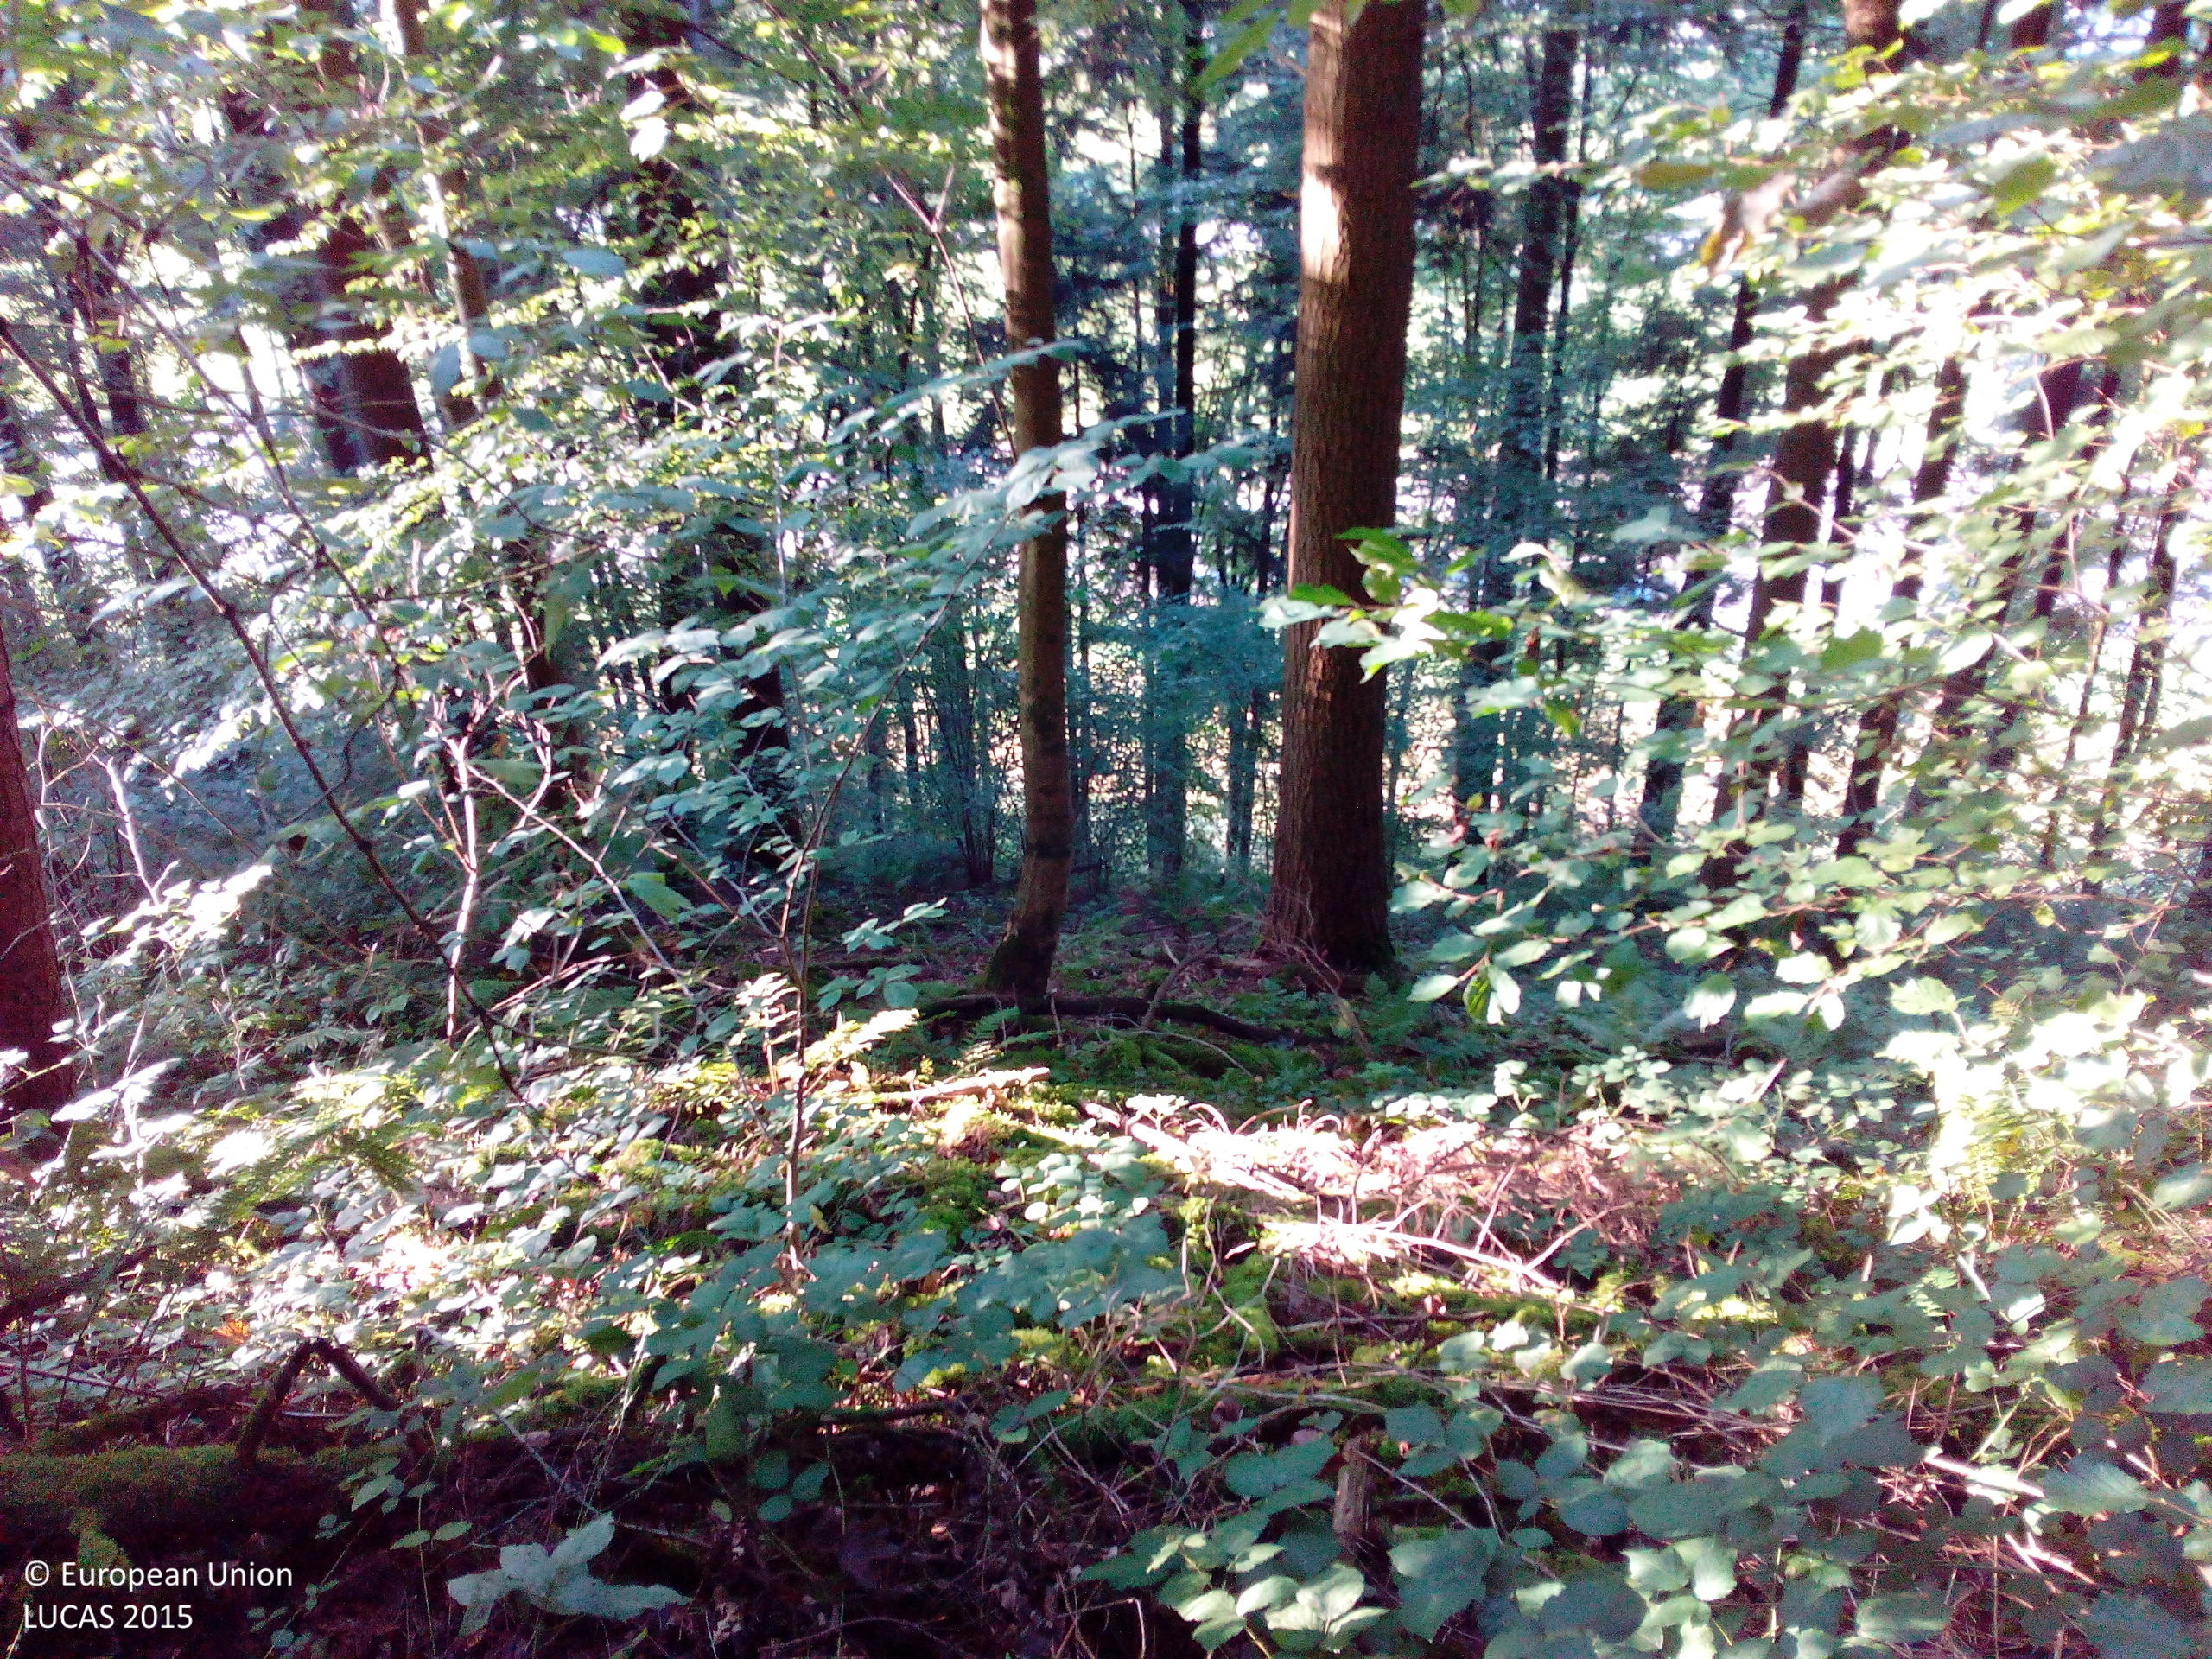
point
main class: Woodland
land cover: Spruce dominated mixed woodland
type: hemiboreal forest and nemoral coniferous forest and mixed broadleaved-coniferous forest
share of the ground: 50 - 75 %
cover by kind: coniferous forest trees 50 %, broadleaved forest trees 20 %, shrubs 10 %, herbaceous plants 10 %, lichens and mosses 10 %
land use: Forestry
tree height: > 5 m
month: September
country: DE
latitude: 48.2796
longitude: 8.1278
